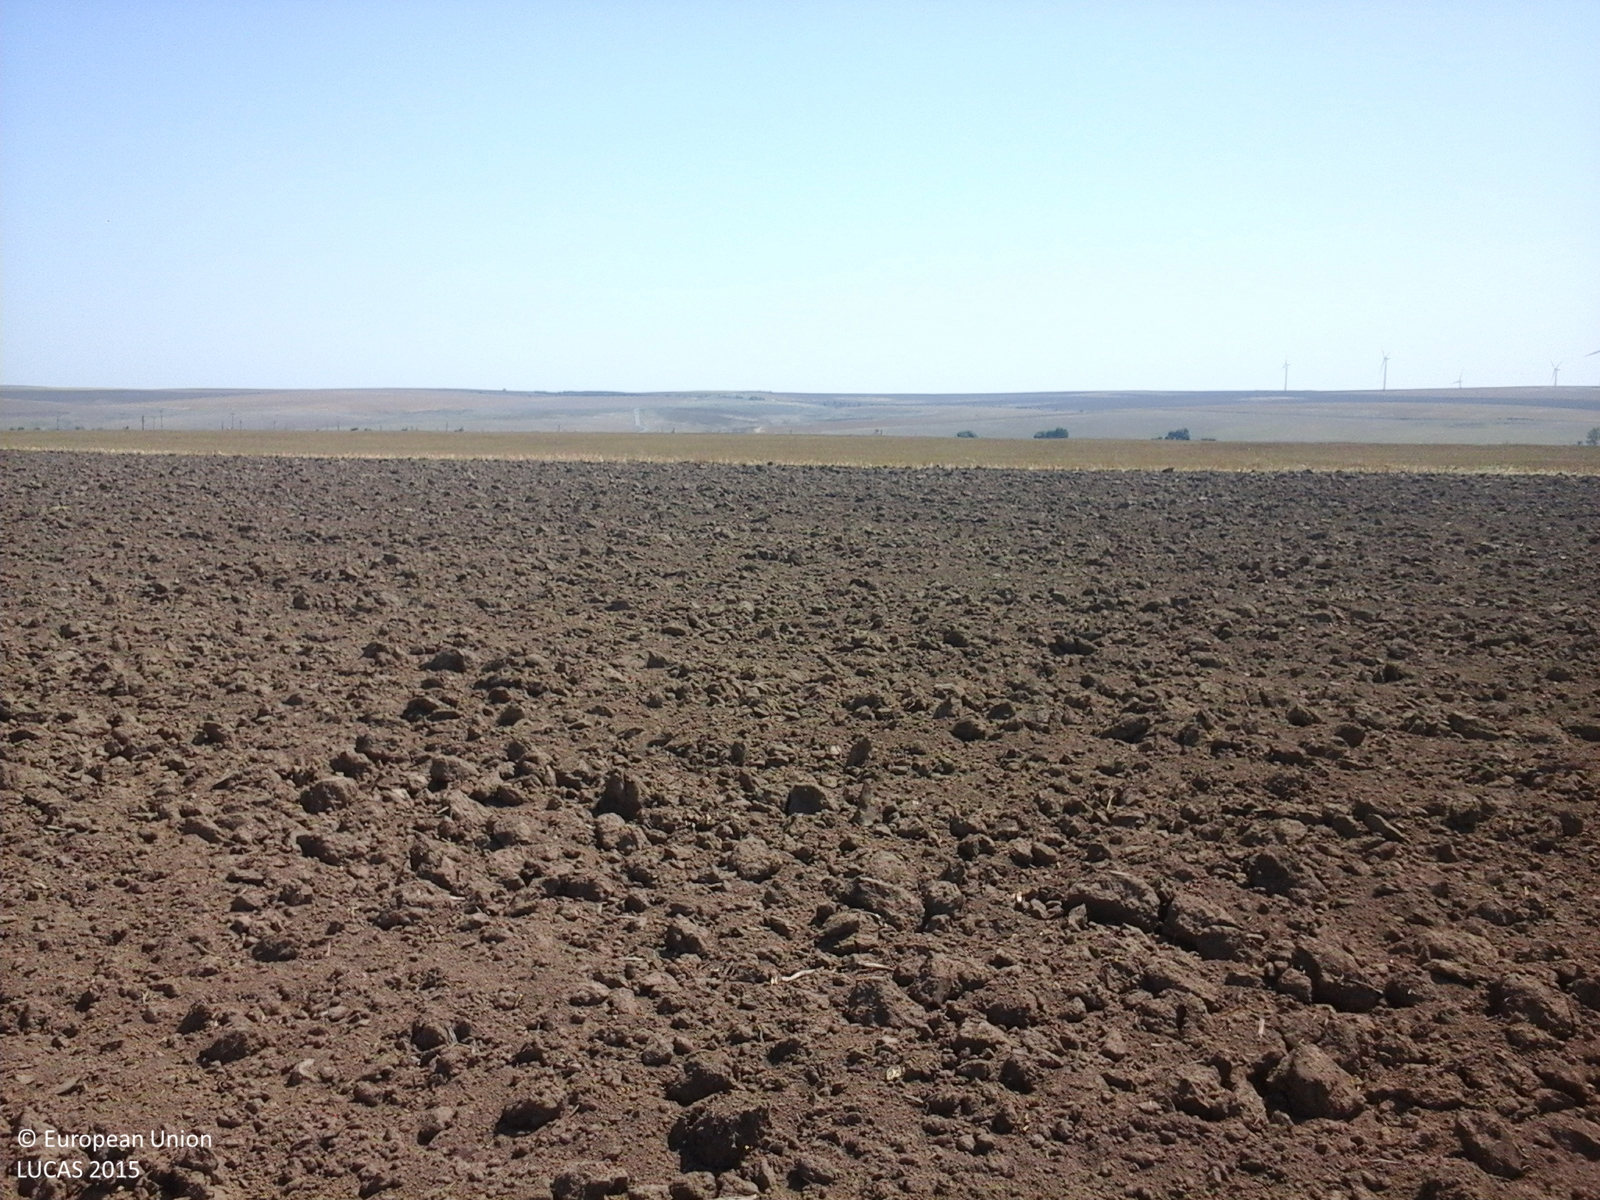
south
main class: Cropland
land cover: Durum wheat
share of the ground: < 10 %
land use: Agriculture (excluding fallow land and kitchen gardens)
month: August
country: RO
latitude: 44.4718
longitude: 28.4369
